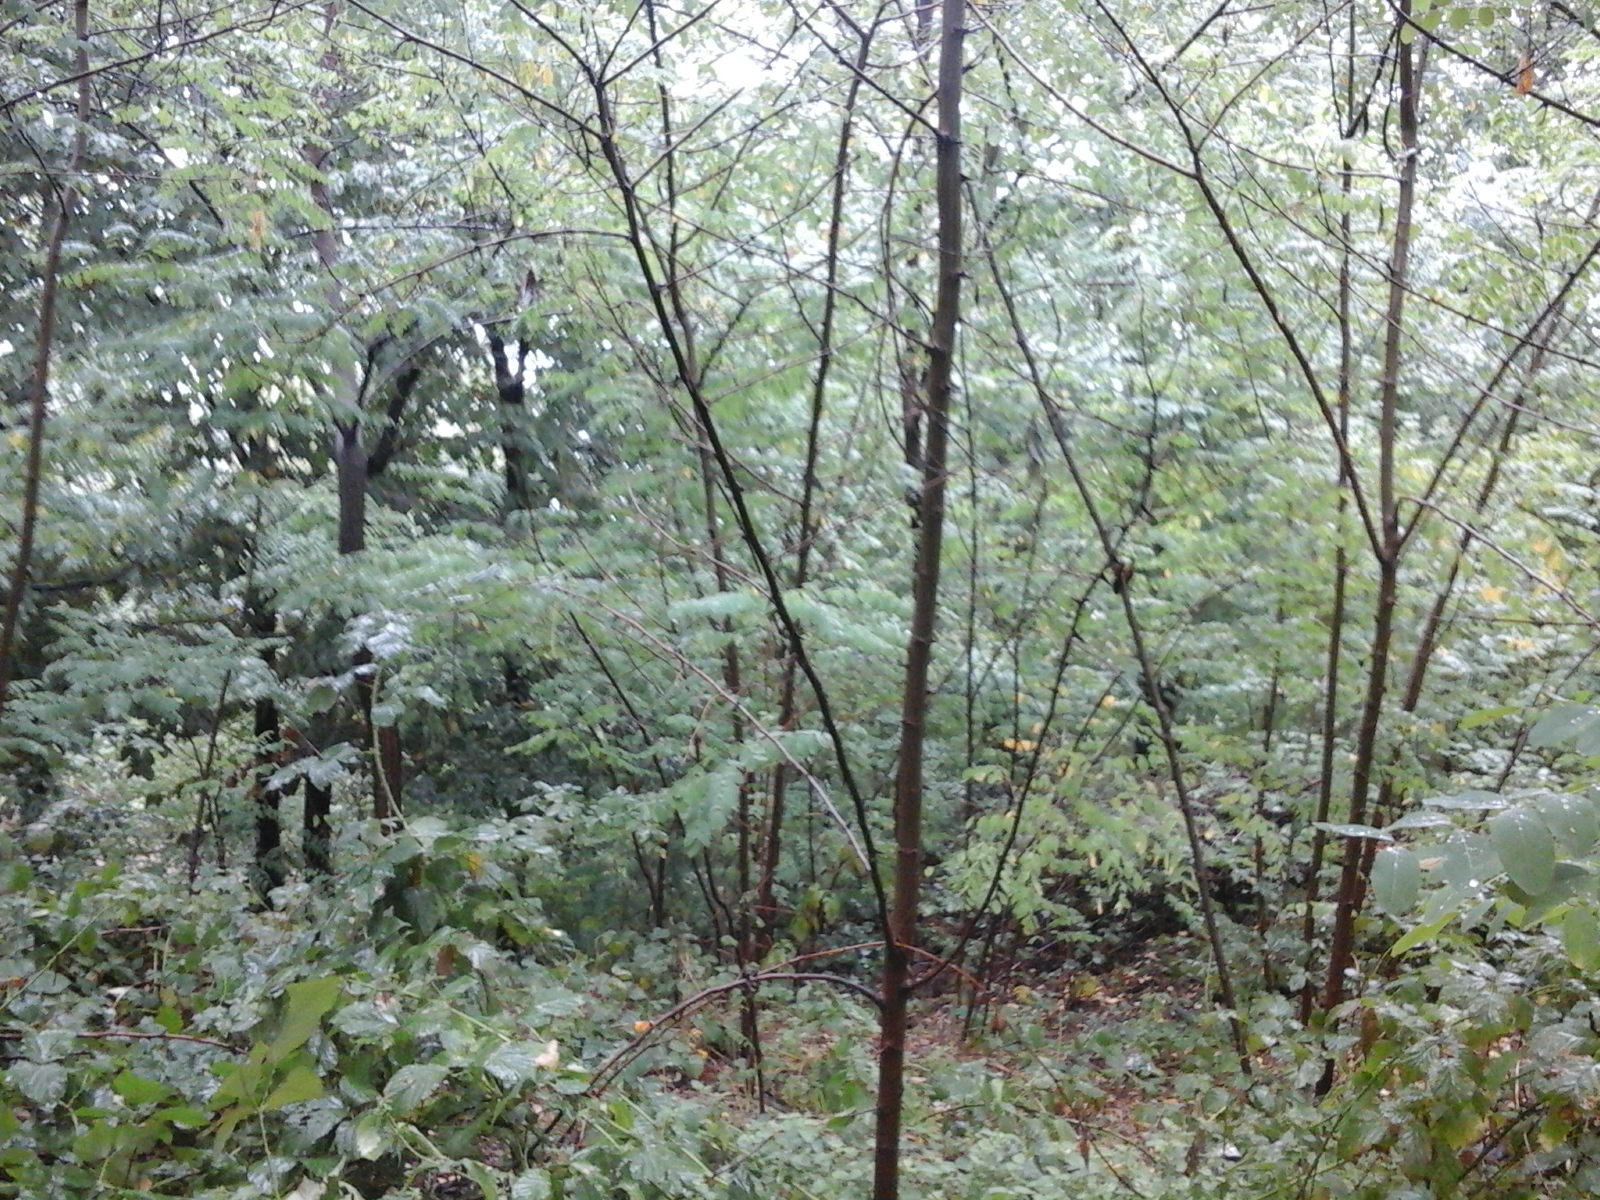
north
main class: Woodland
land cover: Broadleaved woodland
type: exotic forest
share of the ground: > 75 %
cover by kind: broadleaved forest trees 100 %
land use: Forestry
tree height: > 5 m
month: September
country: RO
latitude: 45.0192
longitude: 23.7544
